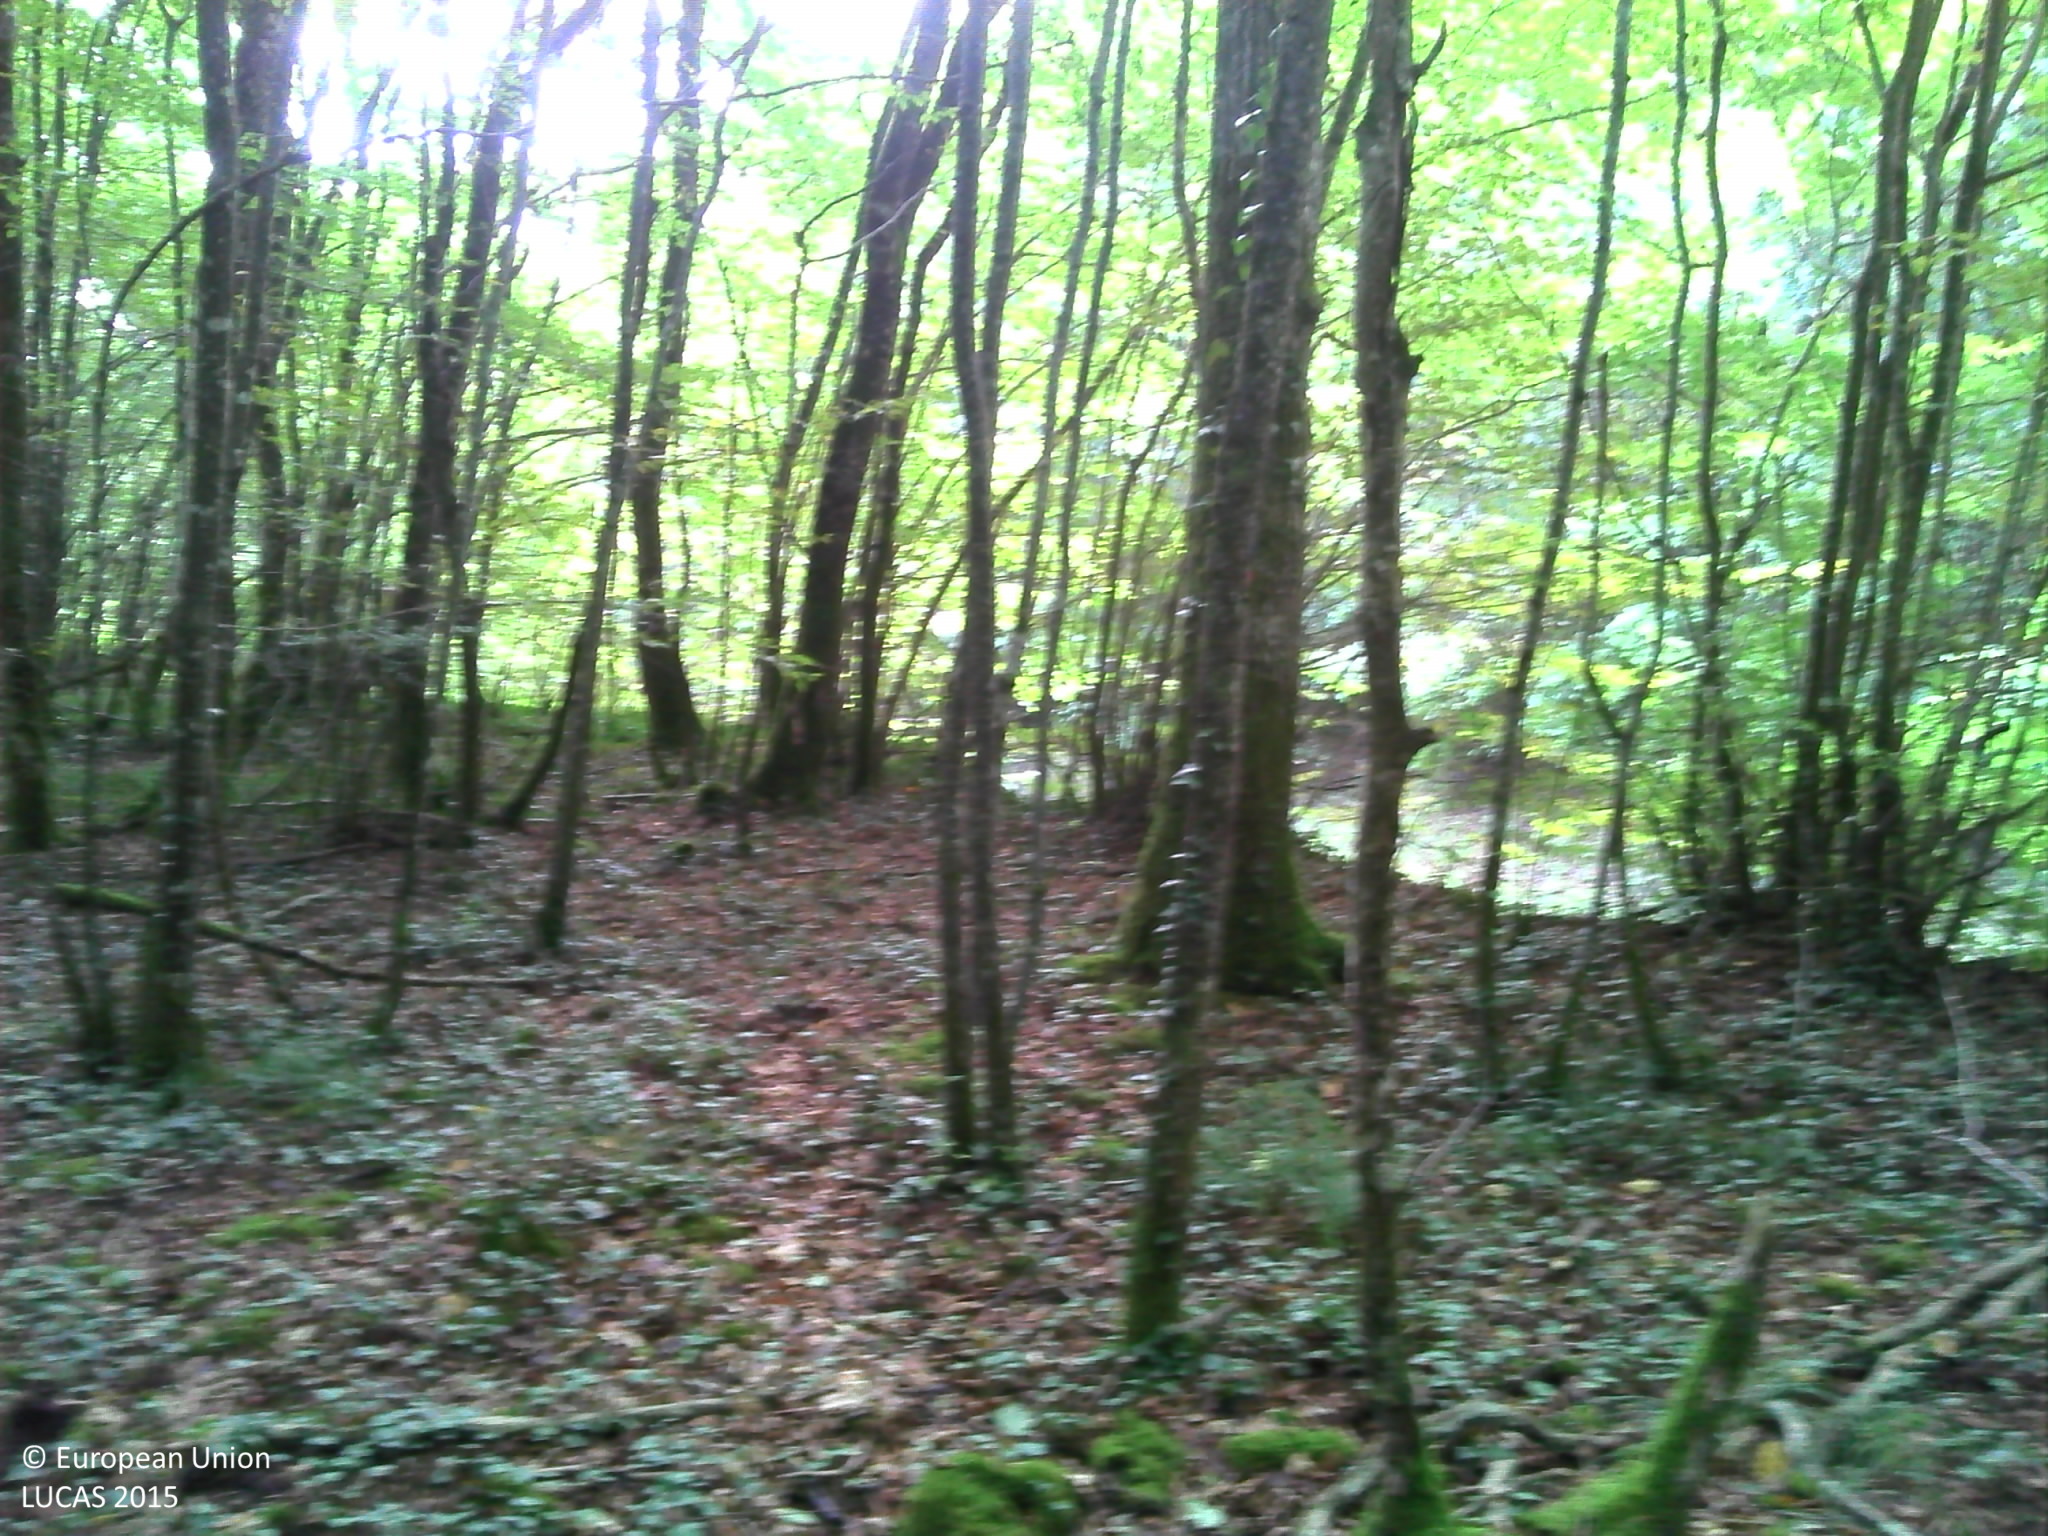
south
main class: Woodland
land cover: Broadleaved woodland
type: mesophytic deciduous forest
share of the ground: > 75 %
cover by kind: broadleaved forest trees 90 %, herbaceous plants 5 %, lichens and mosses 5 %
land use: Forestry
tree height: > 5 m
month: September
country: FR
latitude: 47.9309
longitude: 4.2823
